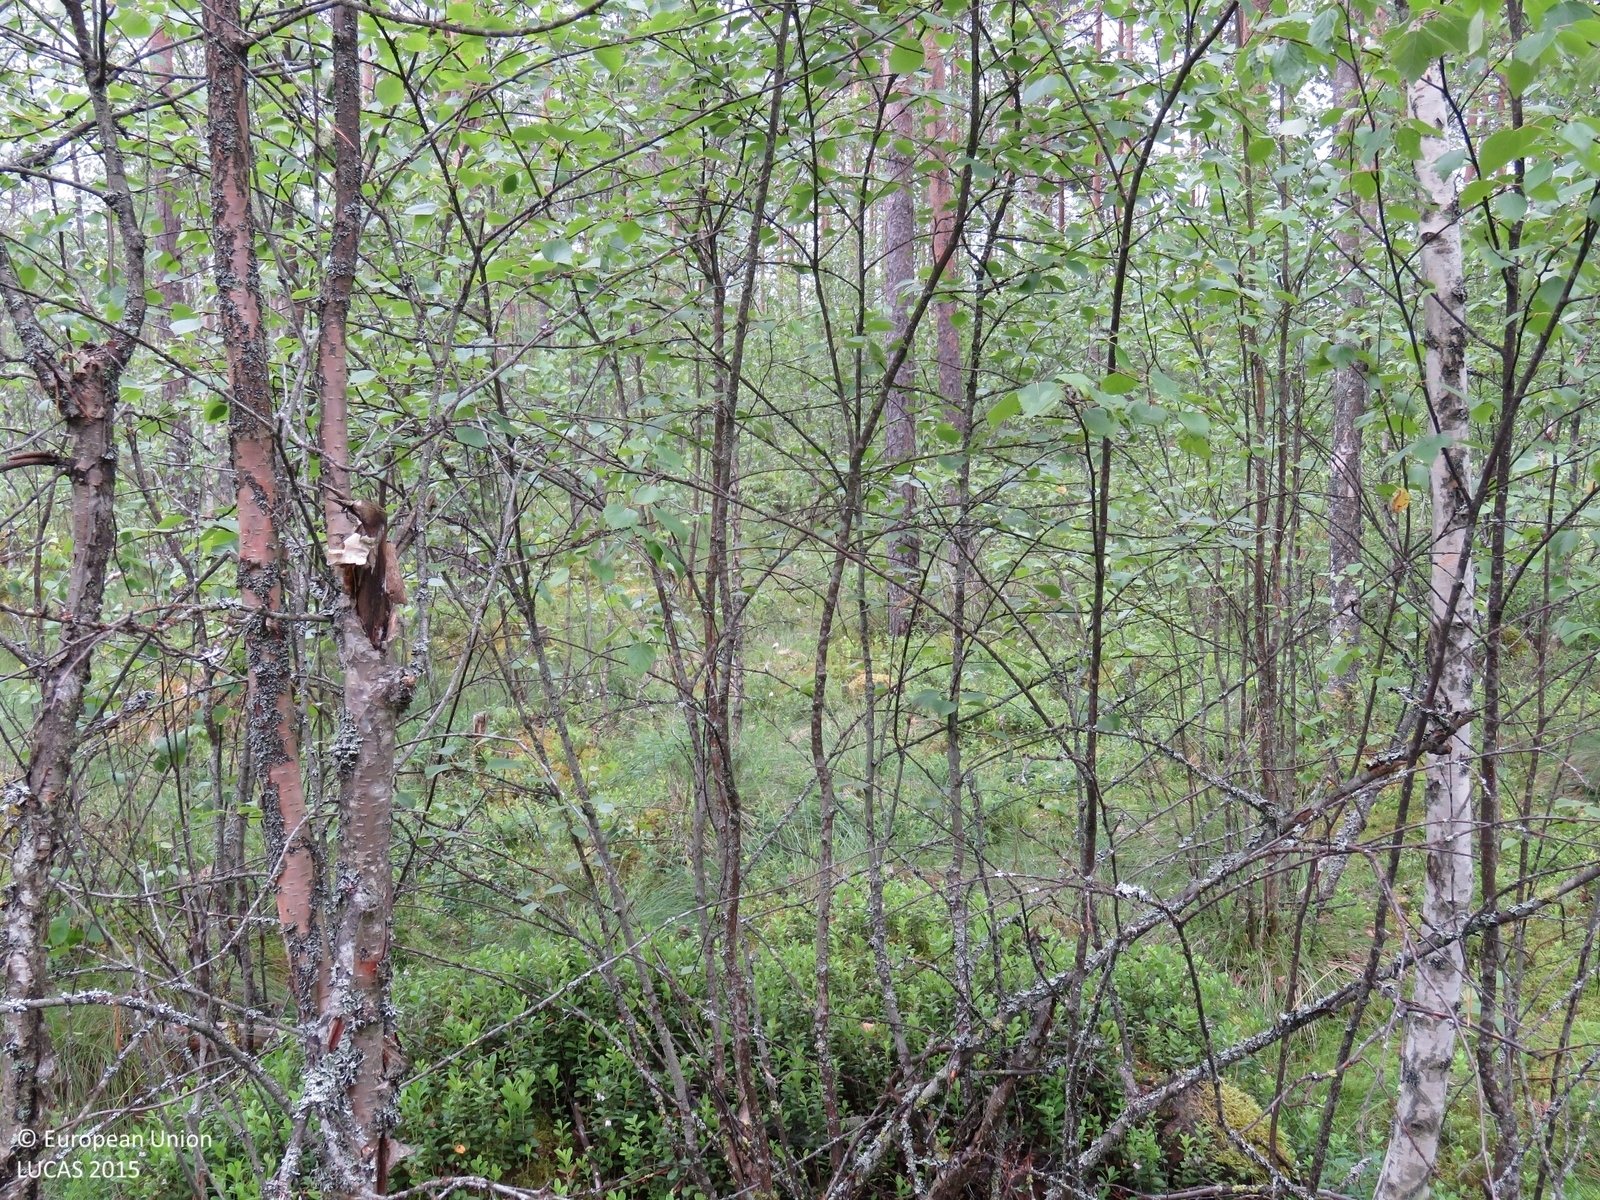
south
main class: Woodland
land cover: Pine dominated mixed woodland
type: boreal forest
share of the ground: > 75 %
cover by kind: broadleaved forest trees 50 %, coniferous forest trees 40 %, shrubs 5 %, herbaceous plants 5 %
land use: Forestry
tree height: > 5 m
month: July
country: FI
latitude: 64.3939
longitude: 26.3499
